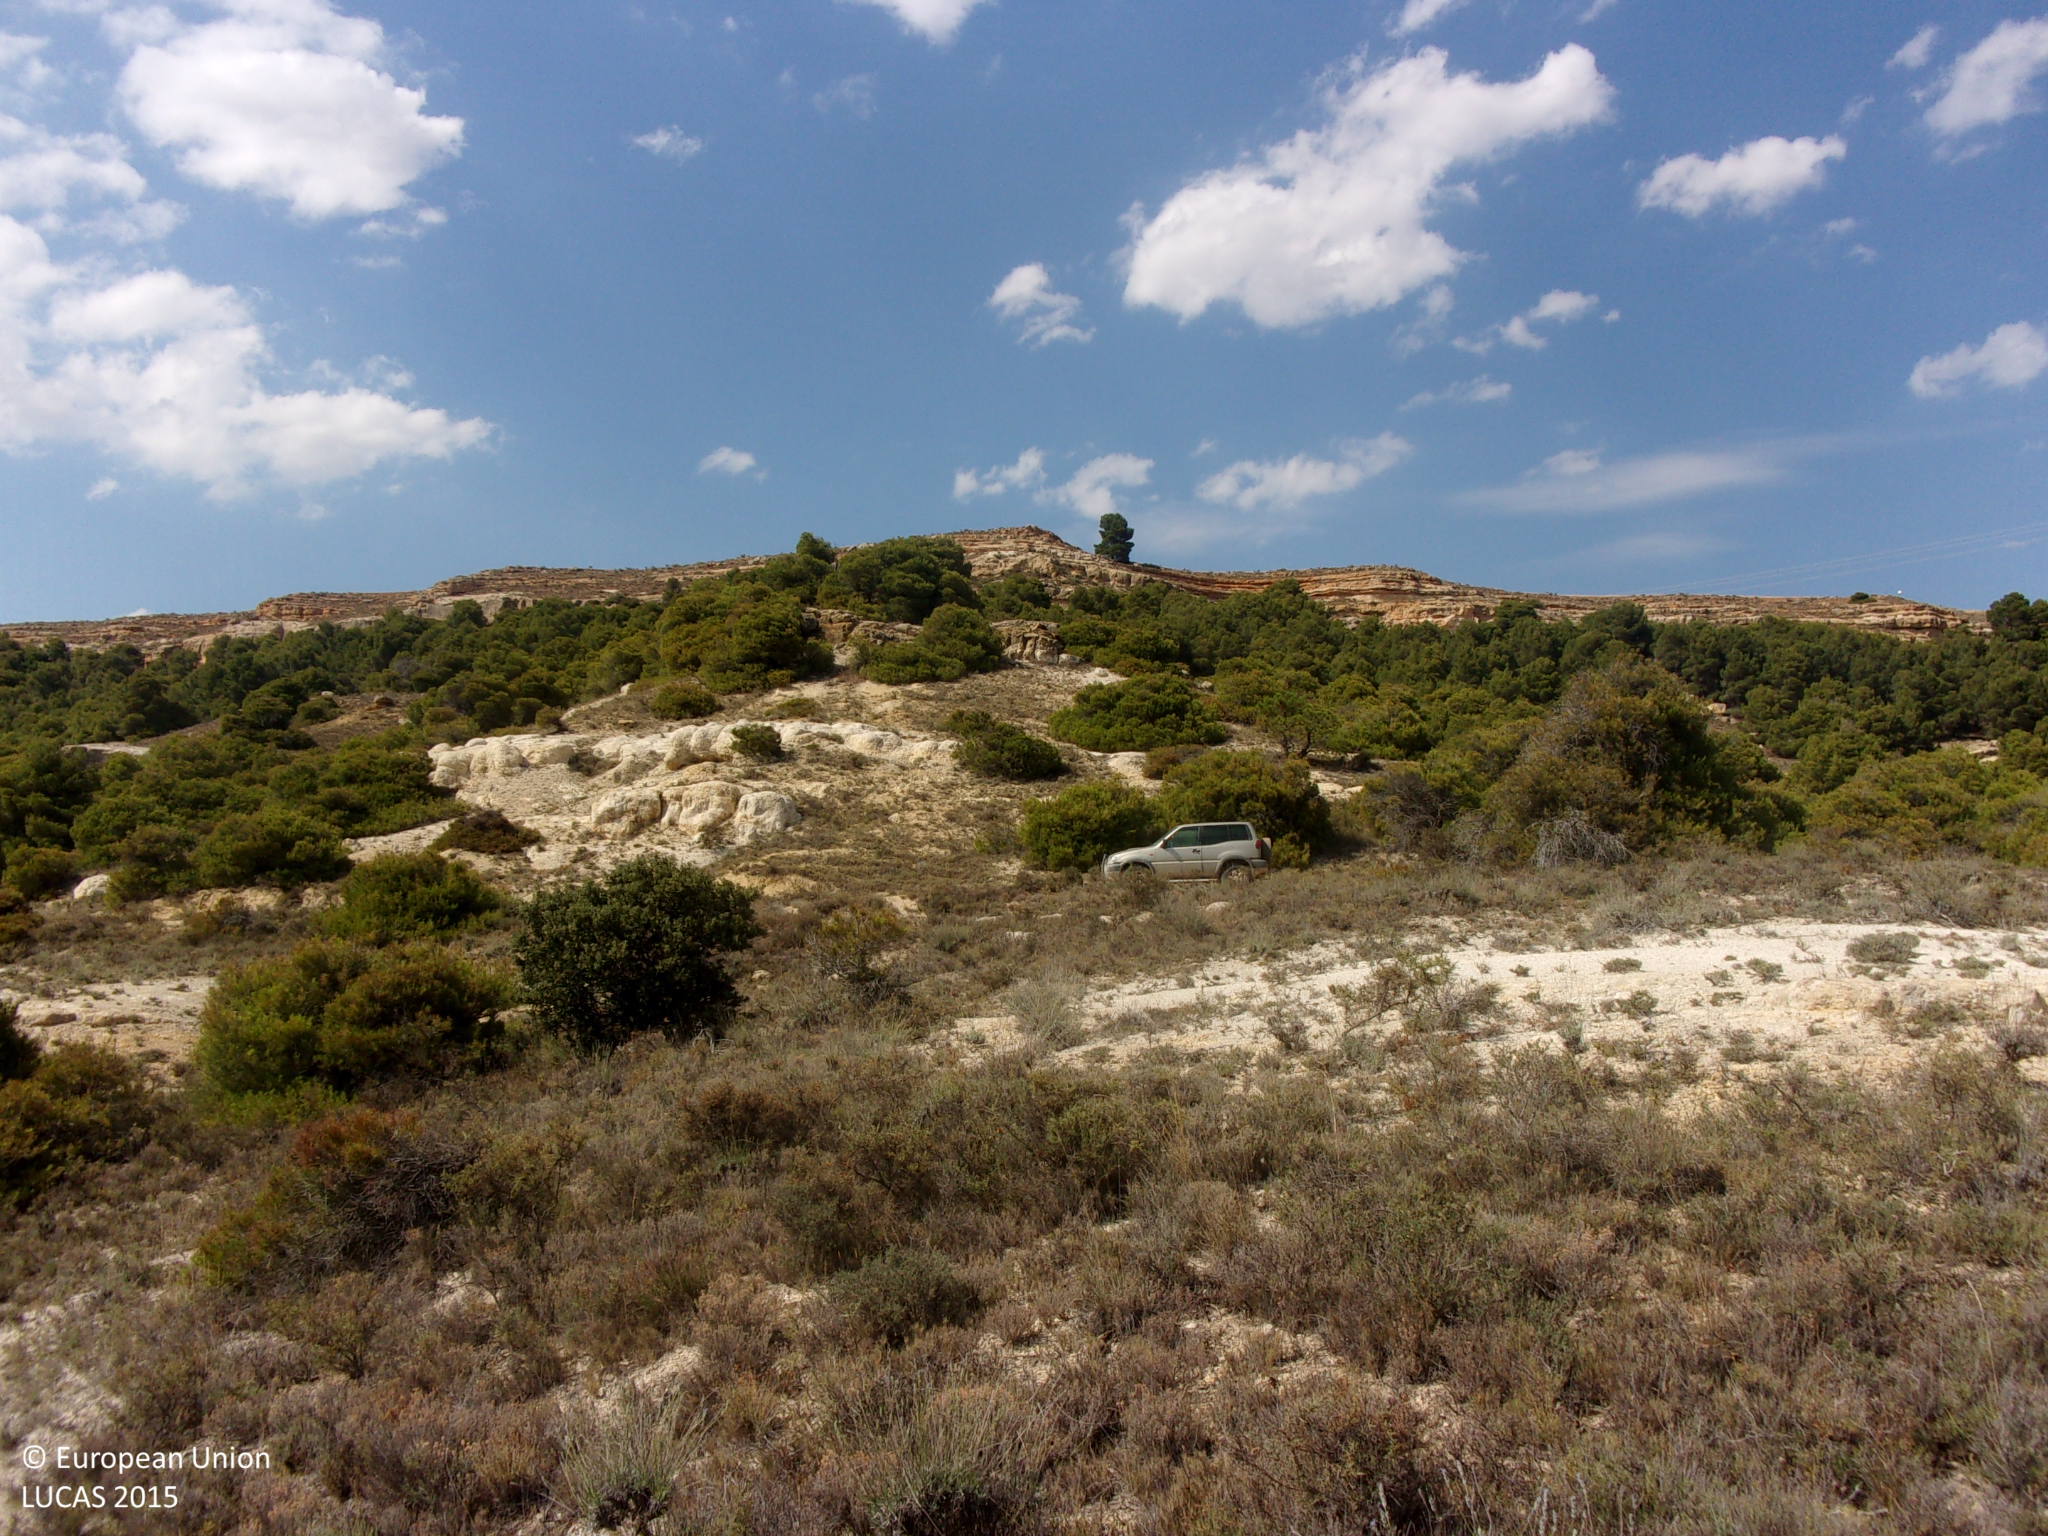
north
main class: Shrubland
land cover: Shrubland without tree cover
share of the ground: 50 - 75 %
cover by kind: shrubs 60 %, consolidated bare surface 30 %, herbaceous plants 10 %
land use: Semi-natural and natural areas not in use
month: July
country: ES
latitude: 41.1184
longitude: -1.3706
